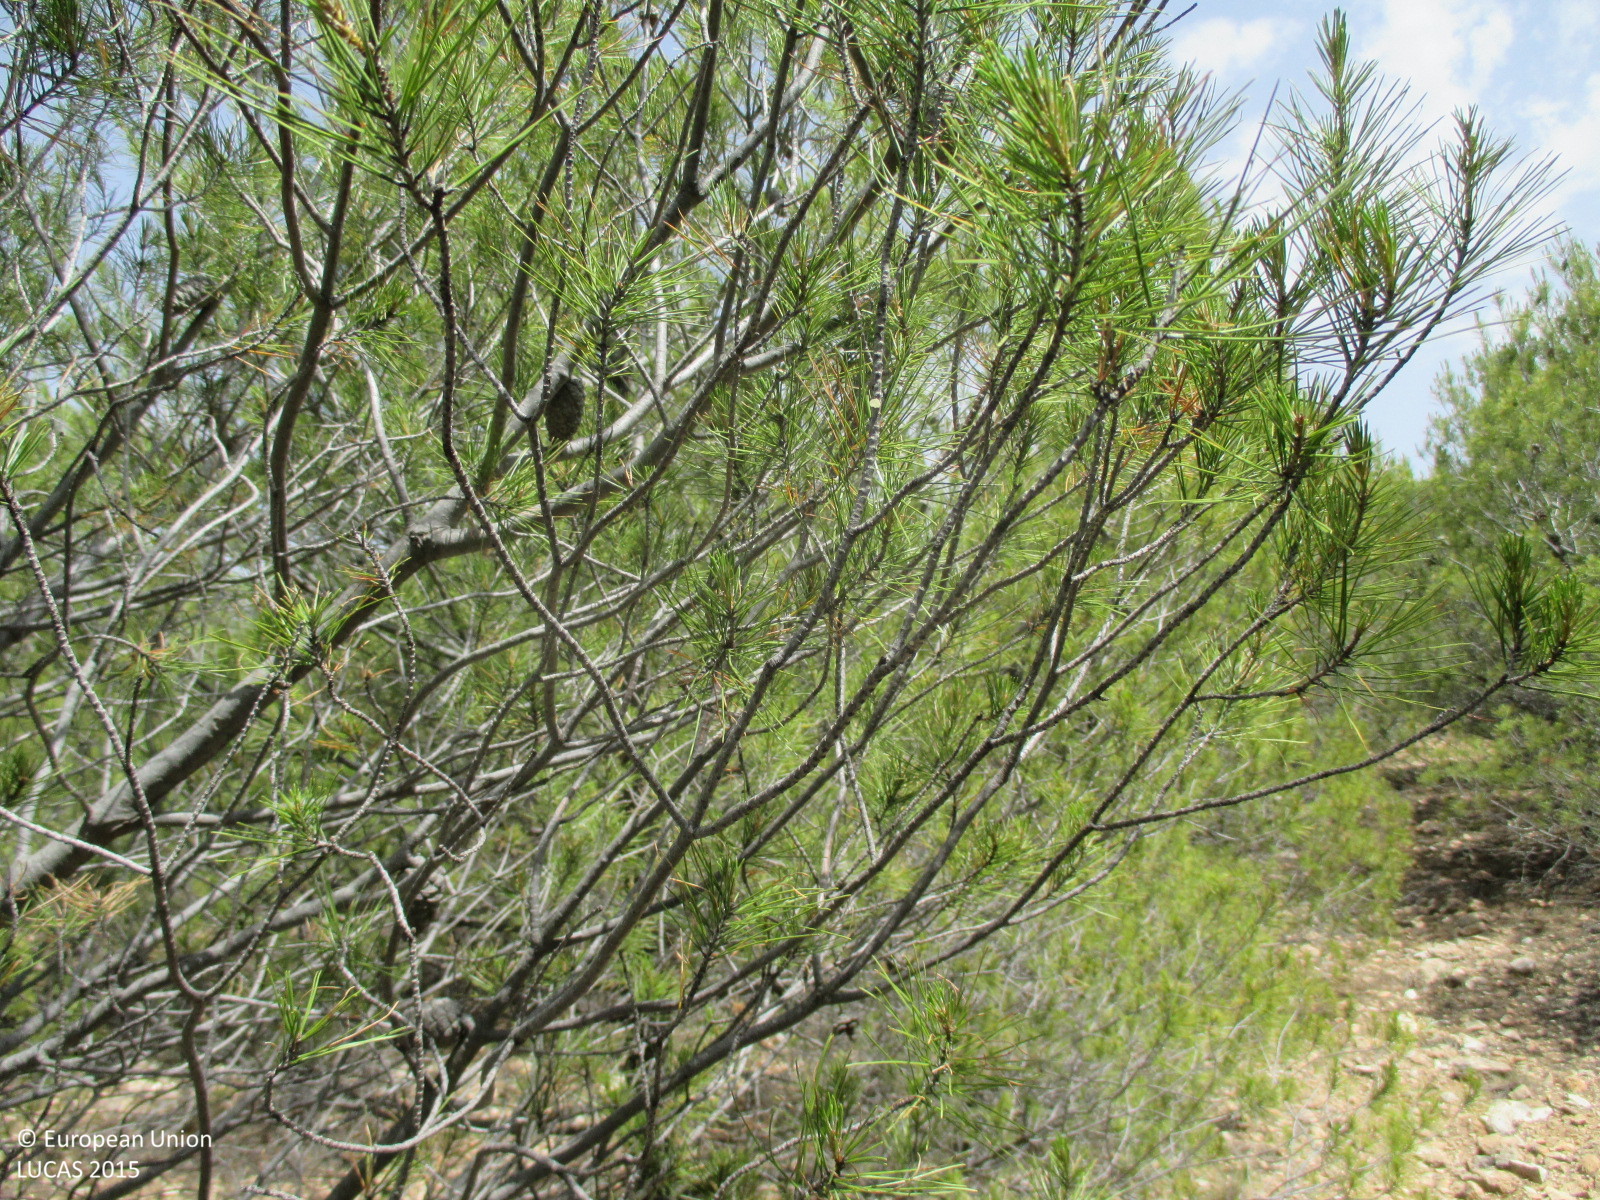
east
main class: Woodland
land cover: Pine dominated coniferous woodland
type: coniferous forest of the mediterranean region
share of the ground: > 75 %
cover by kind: coniferous forest trees 90 %, unconsolidated bare surface 10 %
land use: Forestry
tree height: < 5 m
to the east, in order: Pine dominated coniferous woodland; Other structural elements; Pine dominated coniferous woodland; Other structural elements; Pine dominated coniferous woodland
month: June
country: ES
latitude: 37.6655
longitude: -2.4004
